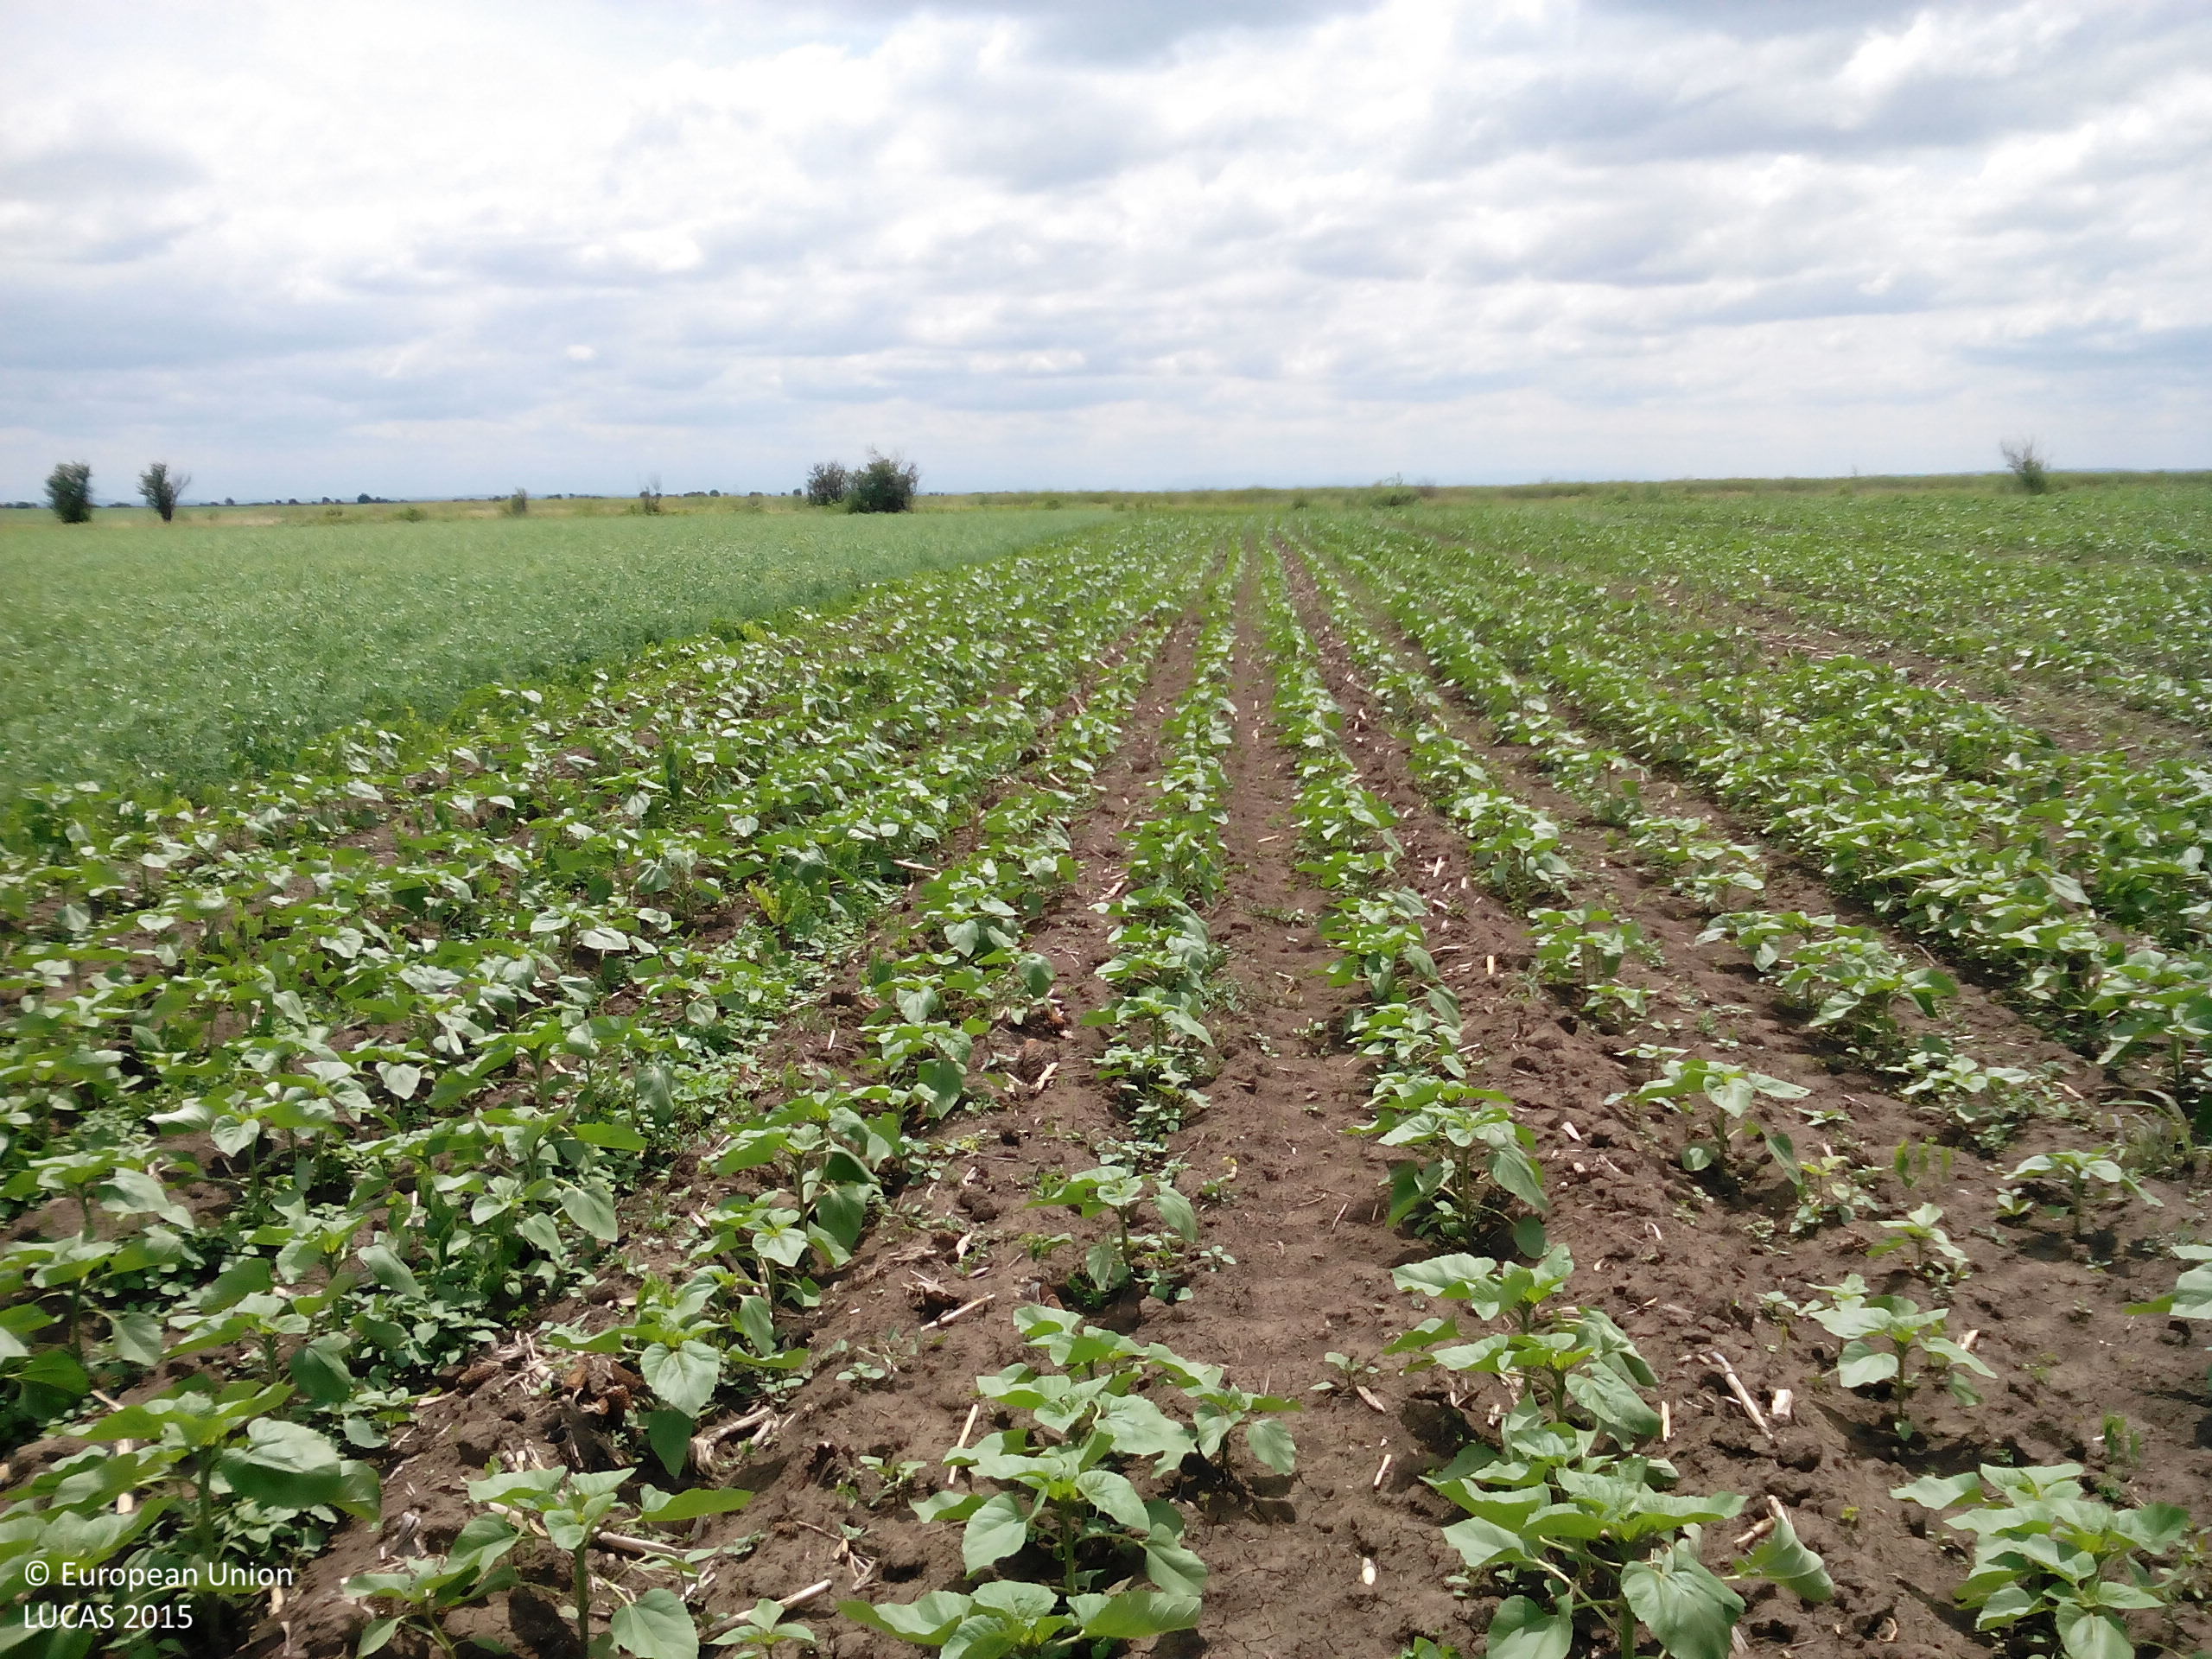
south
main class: Cropland
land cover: Sunflower
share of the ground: 50 - 75 %
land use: Agriculture (excluding fallow land and kitchen gardens)
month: May
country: BG
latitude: 43.5043
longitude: 24.1428
